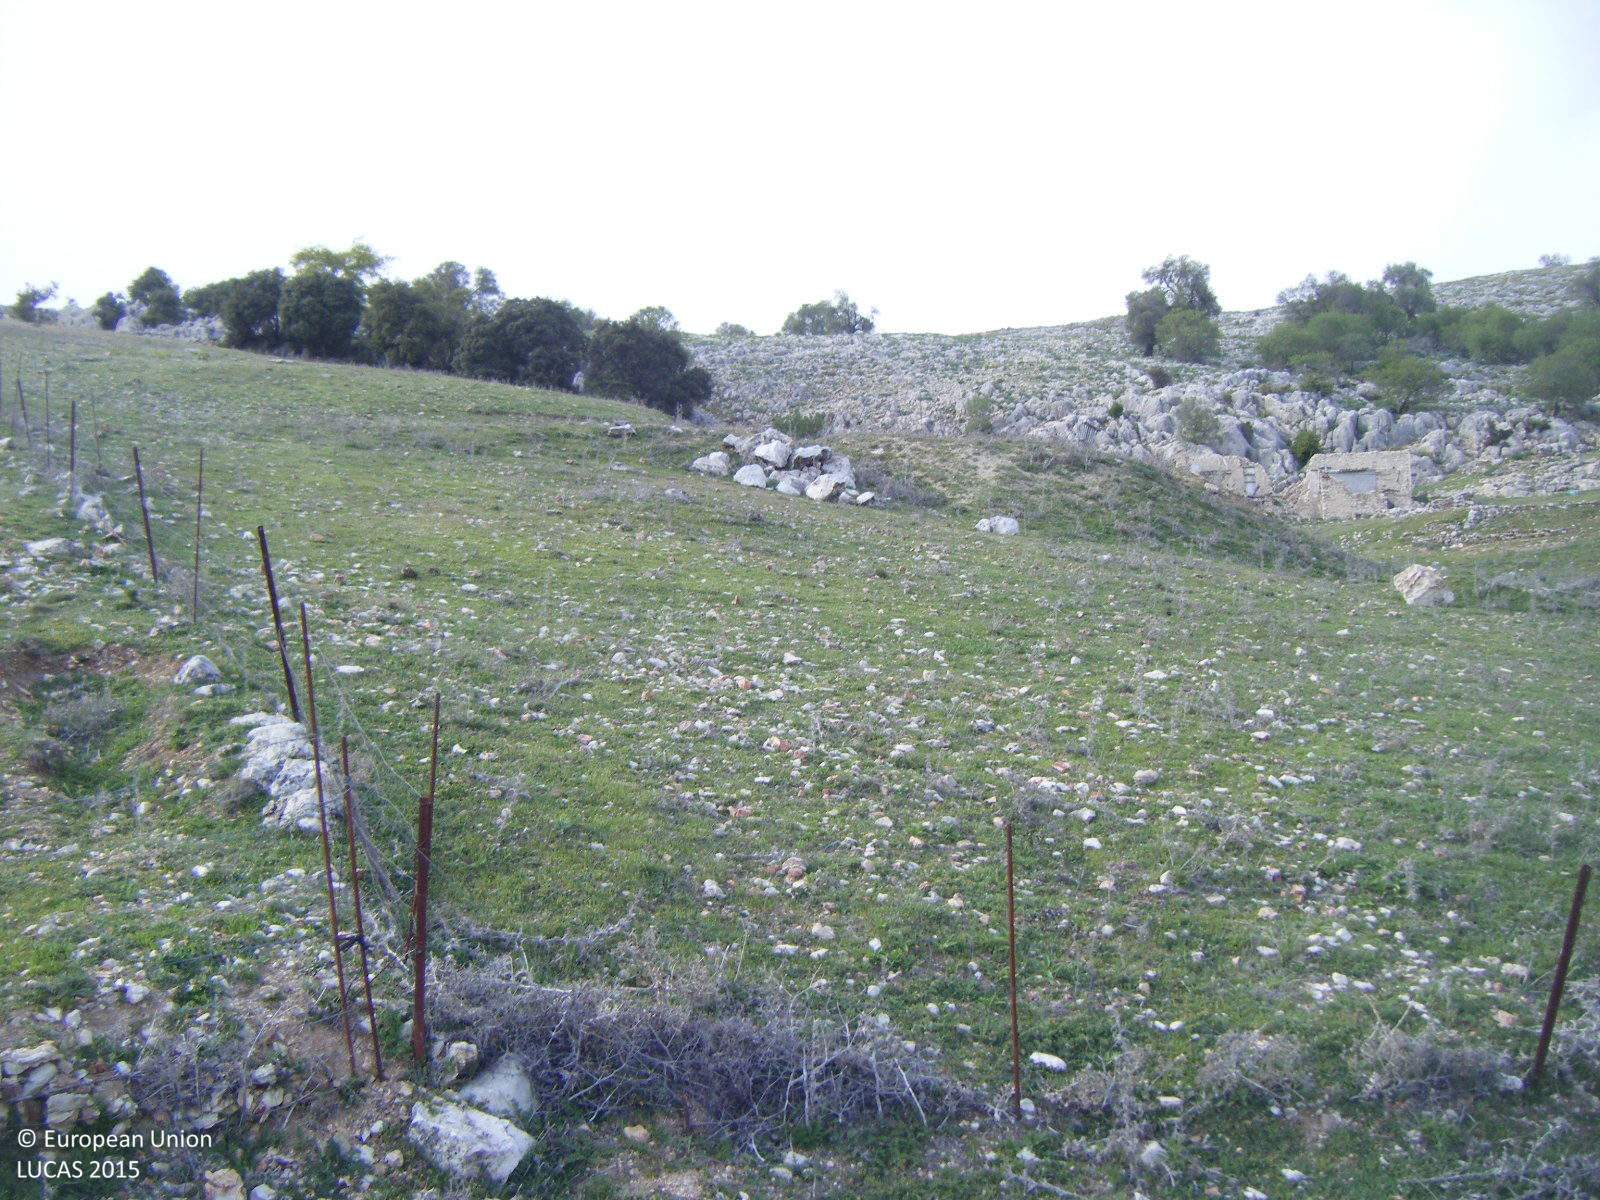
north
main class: Grassland
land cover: Grassland without tree/shrub cover
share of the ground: > 75 %
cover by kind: herbaceous plants 100 %
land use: Agriculture (excluding fallow land and kitchen gardens)
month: April
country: ES
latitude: 37.0157
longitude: -4.1423
